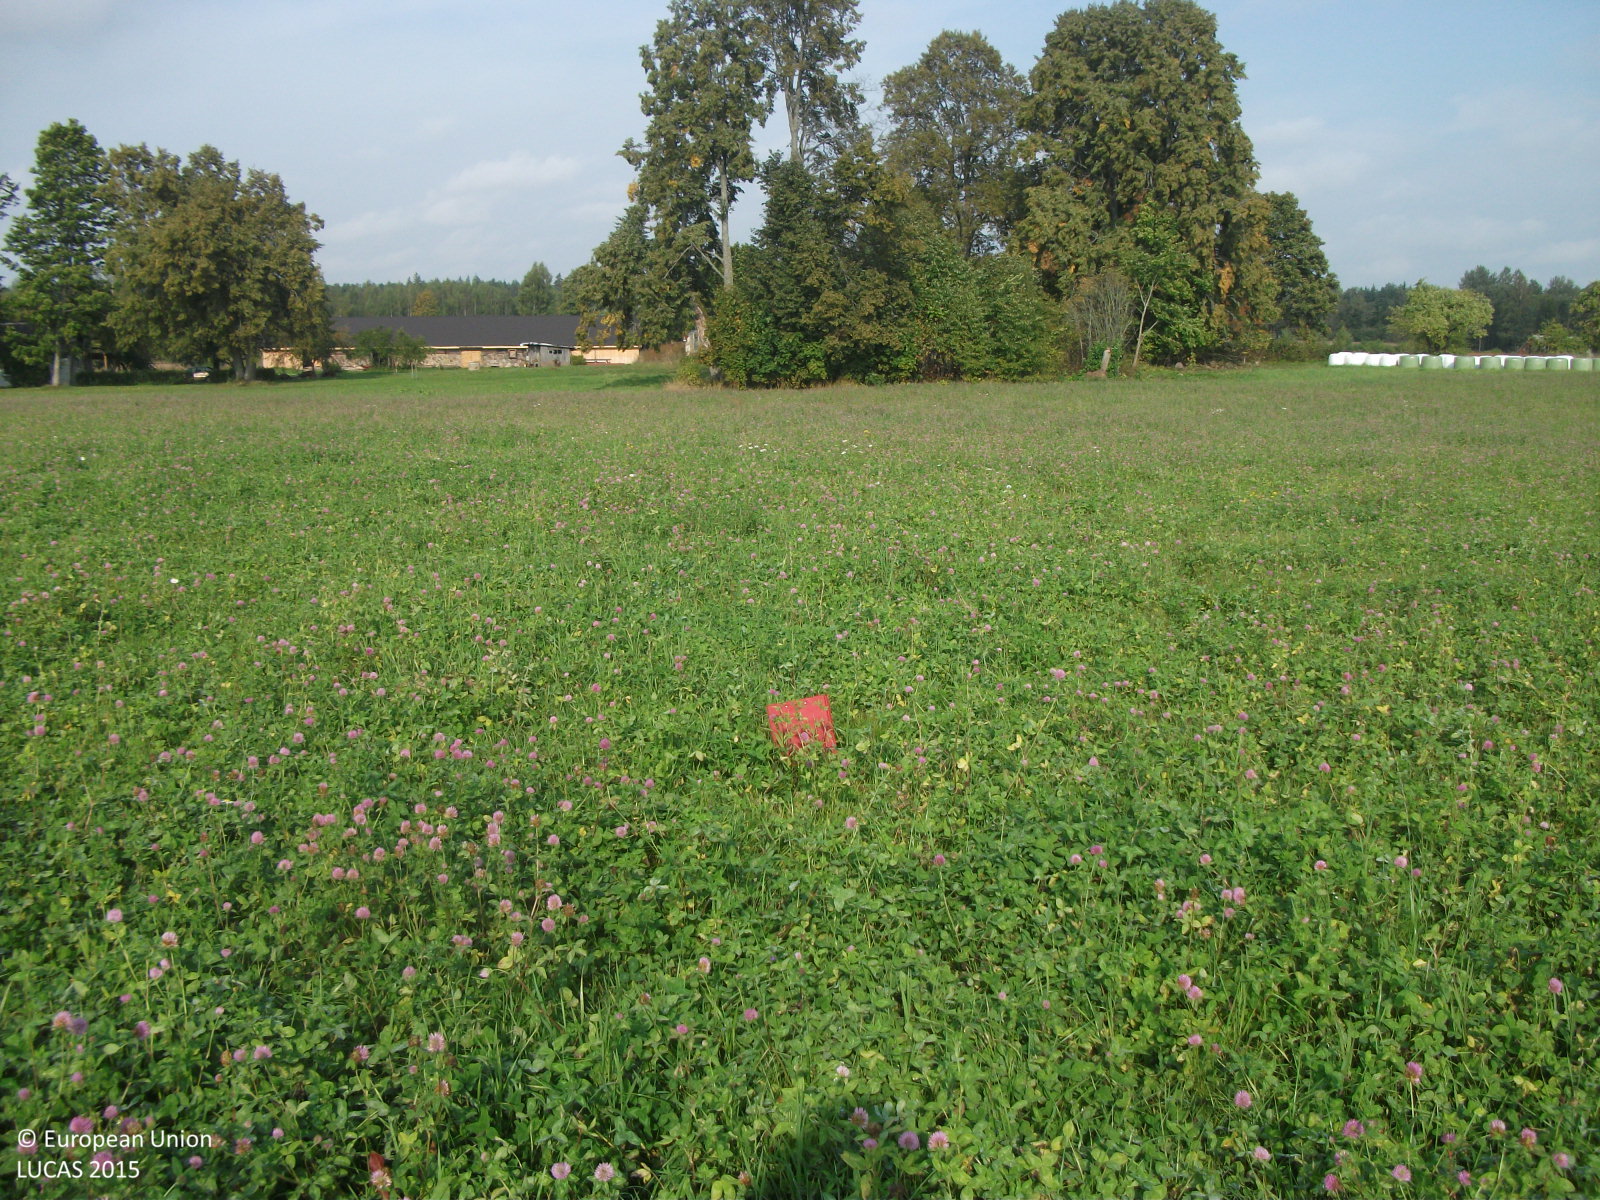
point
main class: Cropland
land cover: Clovers
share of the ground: > 75 %
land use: Agriculture (excluding fallow land and kitchen gardens)
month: September
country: LV
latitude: 57.9001
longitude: 24.8603
